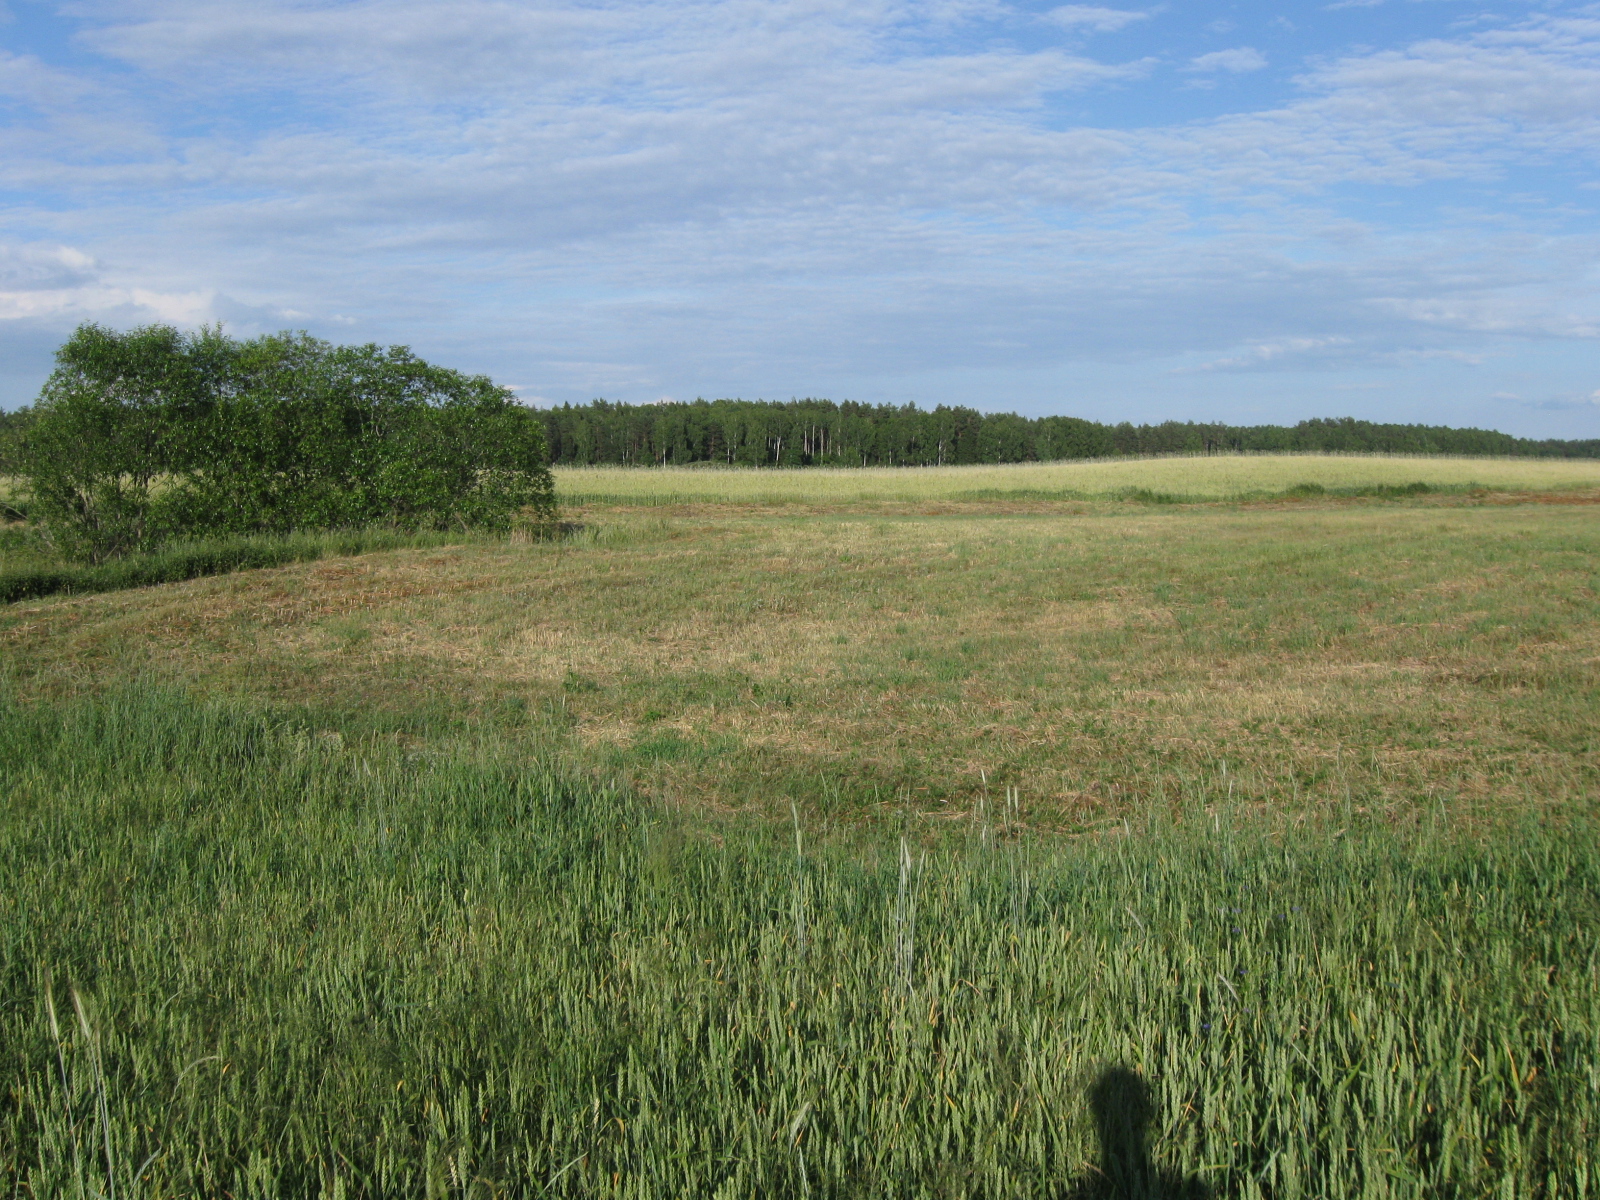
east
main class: Cropland
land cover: Common wheat
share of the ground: > 75 %
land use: Agriculture (excluding fallow land and kitchen gardens)
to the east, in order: Common wheat; Grassland without tree/shrub cover; Common wheat
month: June
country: LT
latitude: 54.2372
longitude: 24.2285
